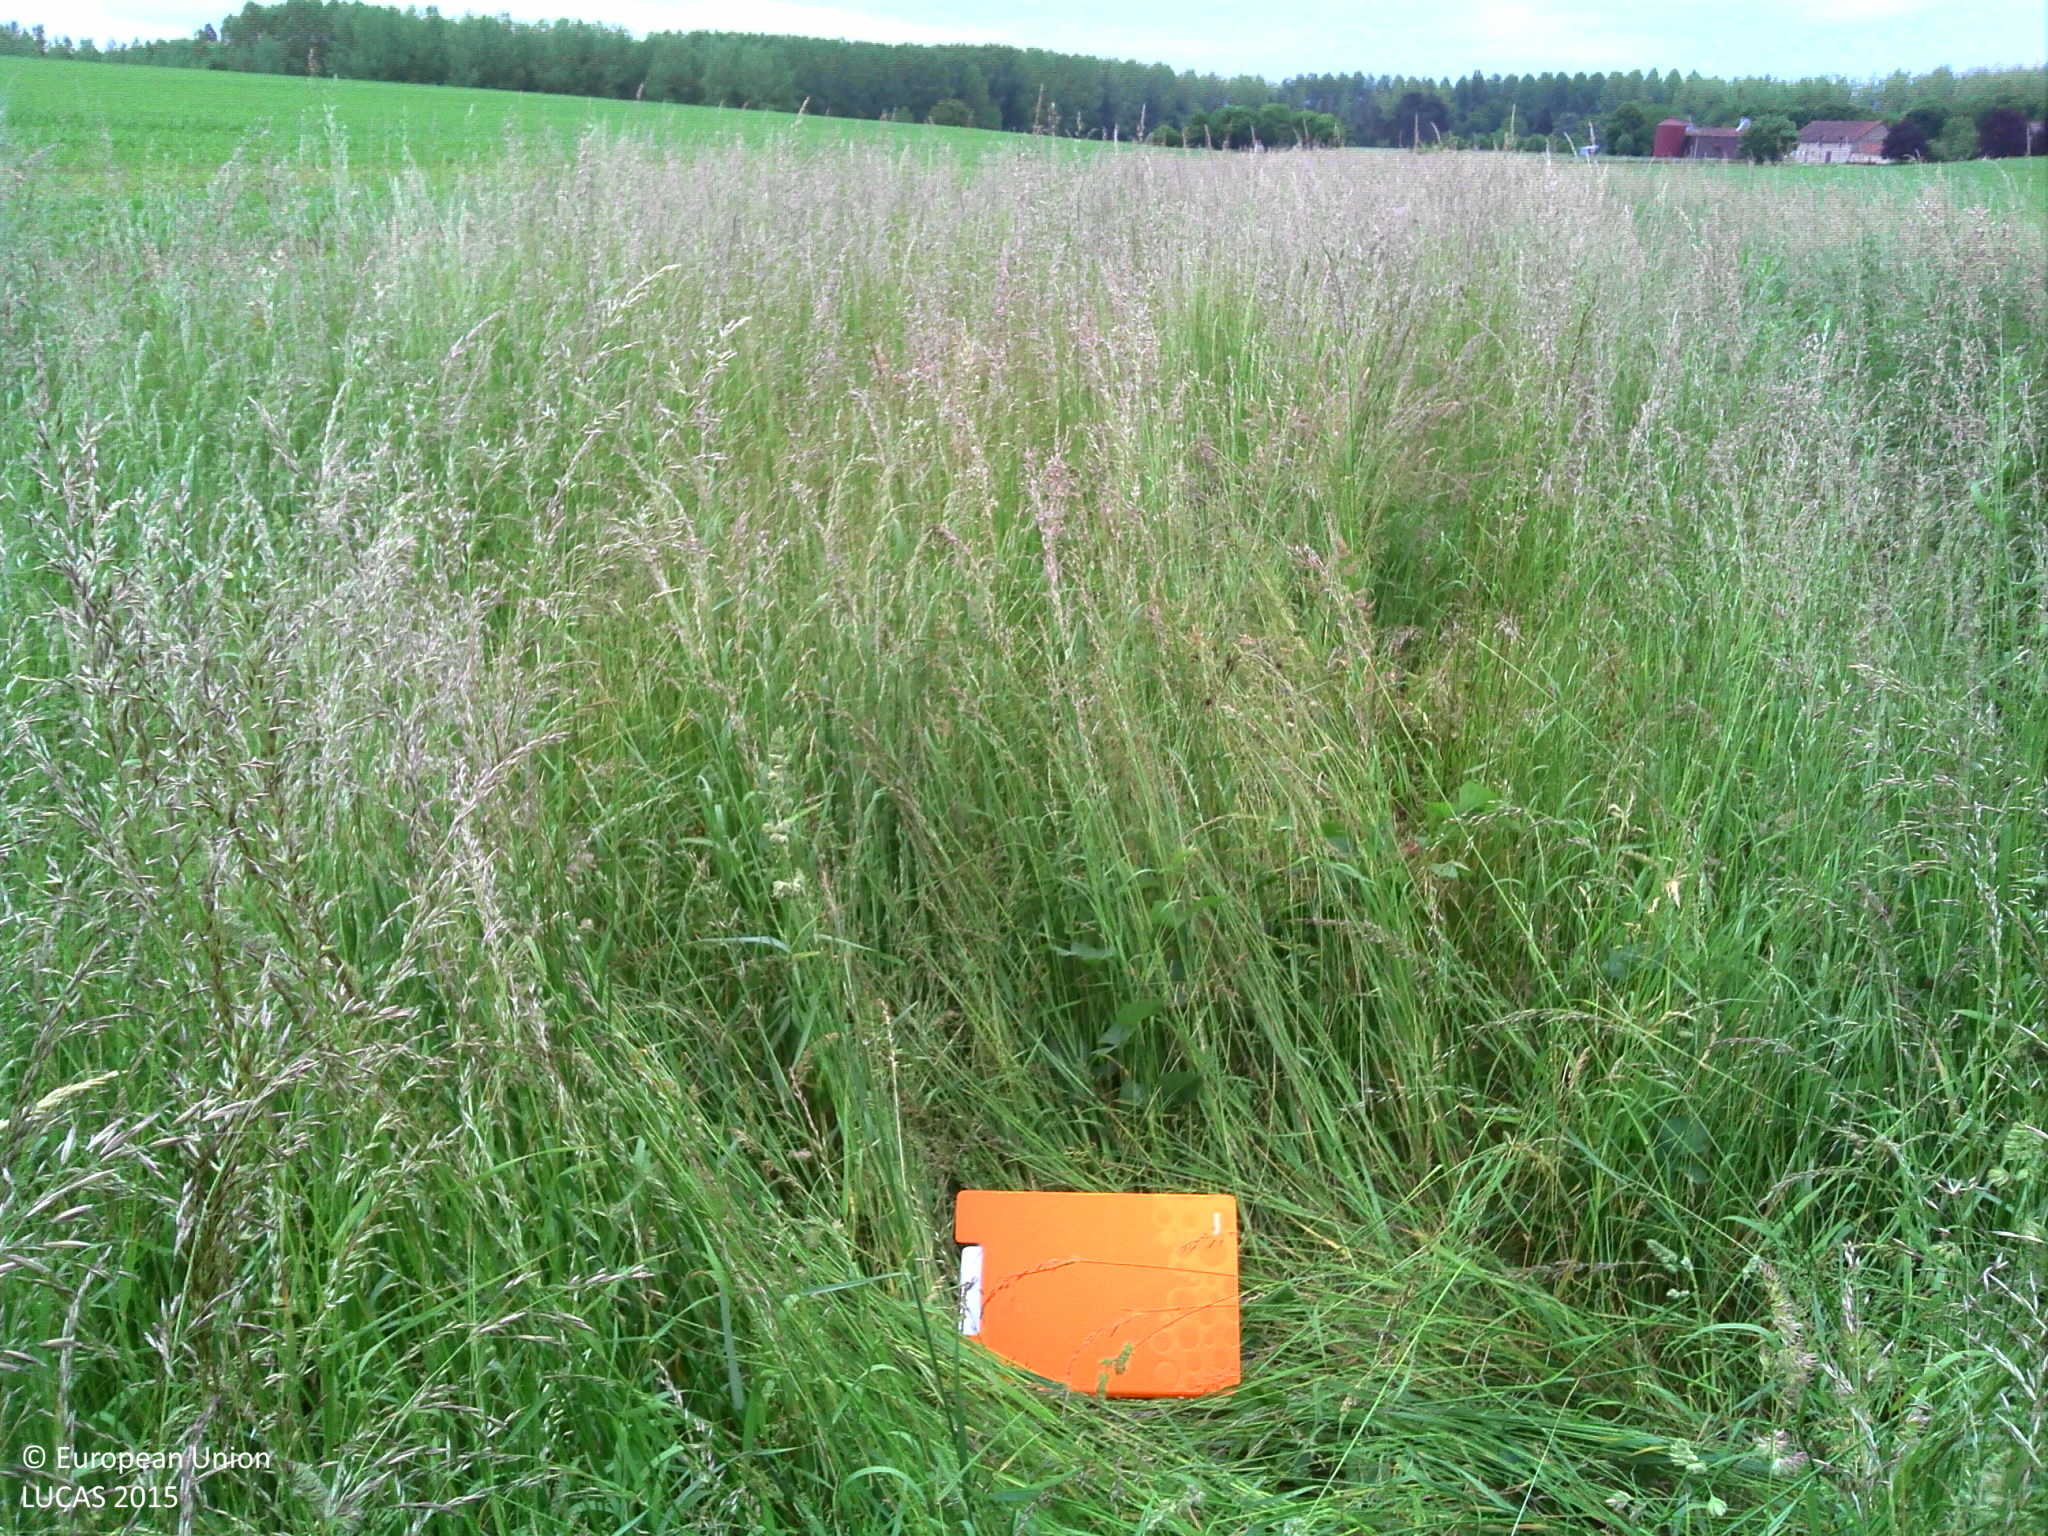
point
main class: Grassland
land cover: Grassland without tree/shrub cover
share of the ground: > 75 %
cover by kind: herbaceous plants 100 %
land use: Agriculture (excluding fallow land and kitchen gardens)
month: May
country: FR
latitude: 47.1463
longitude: 2.9134
